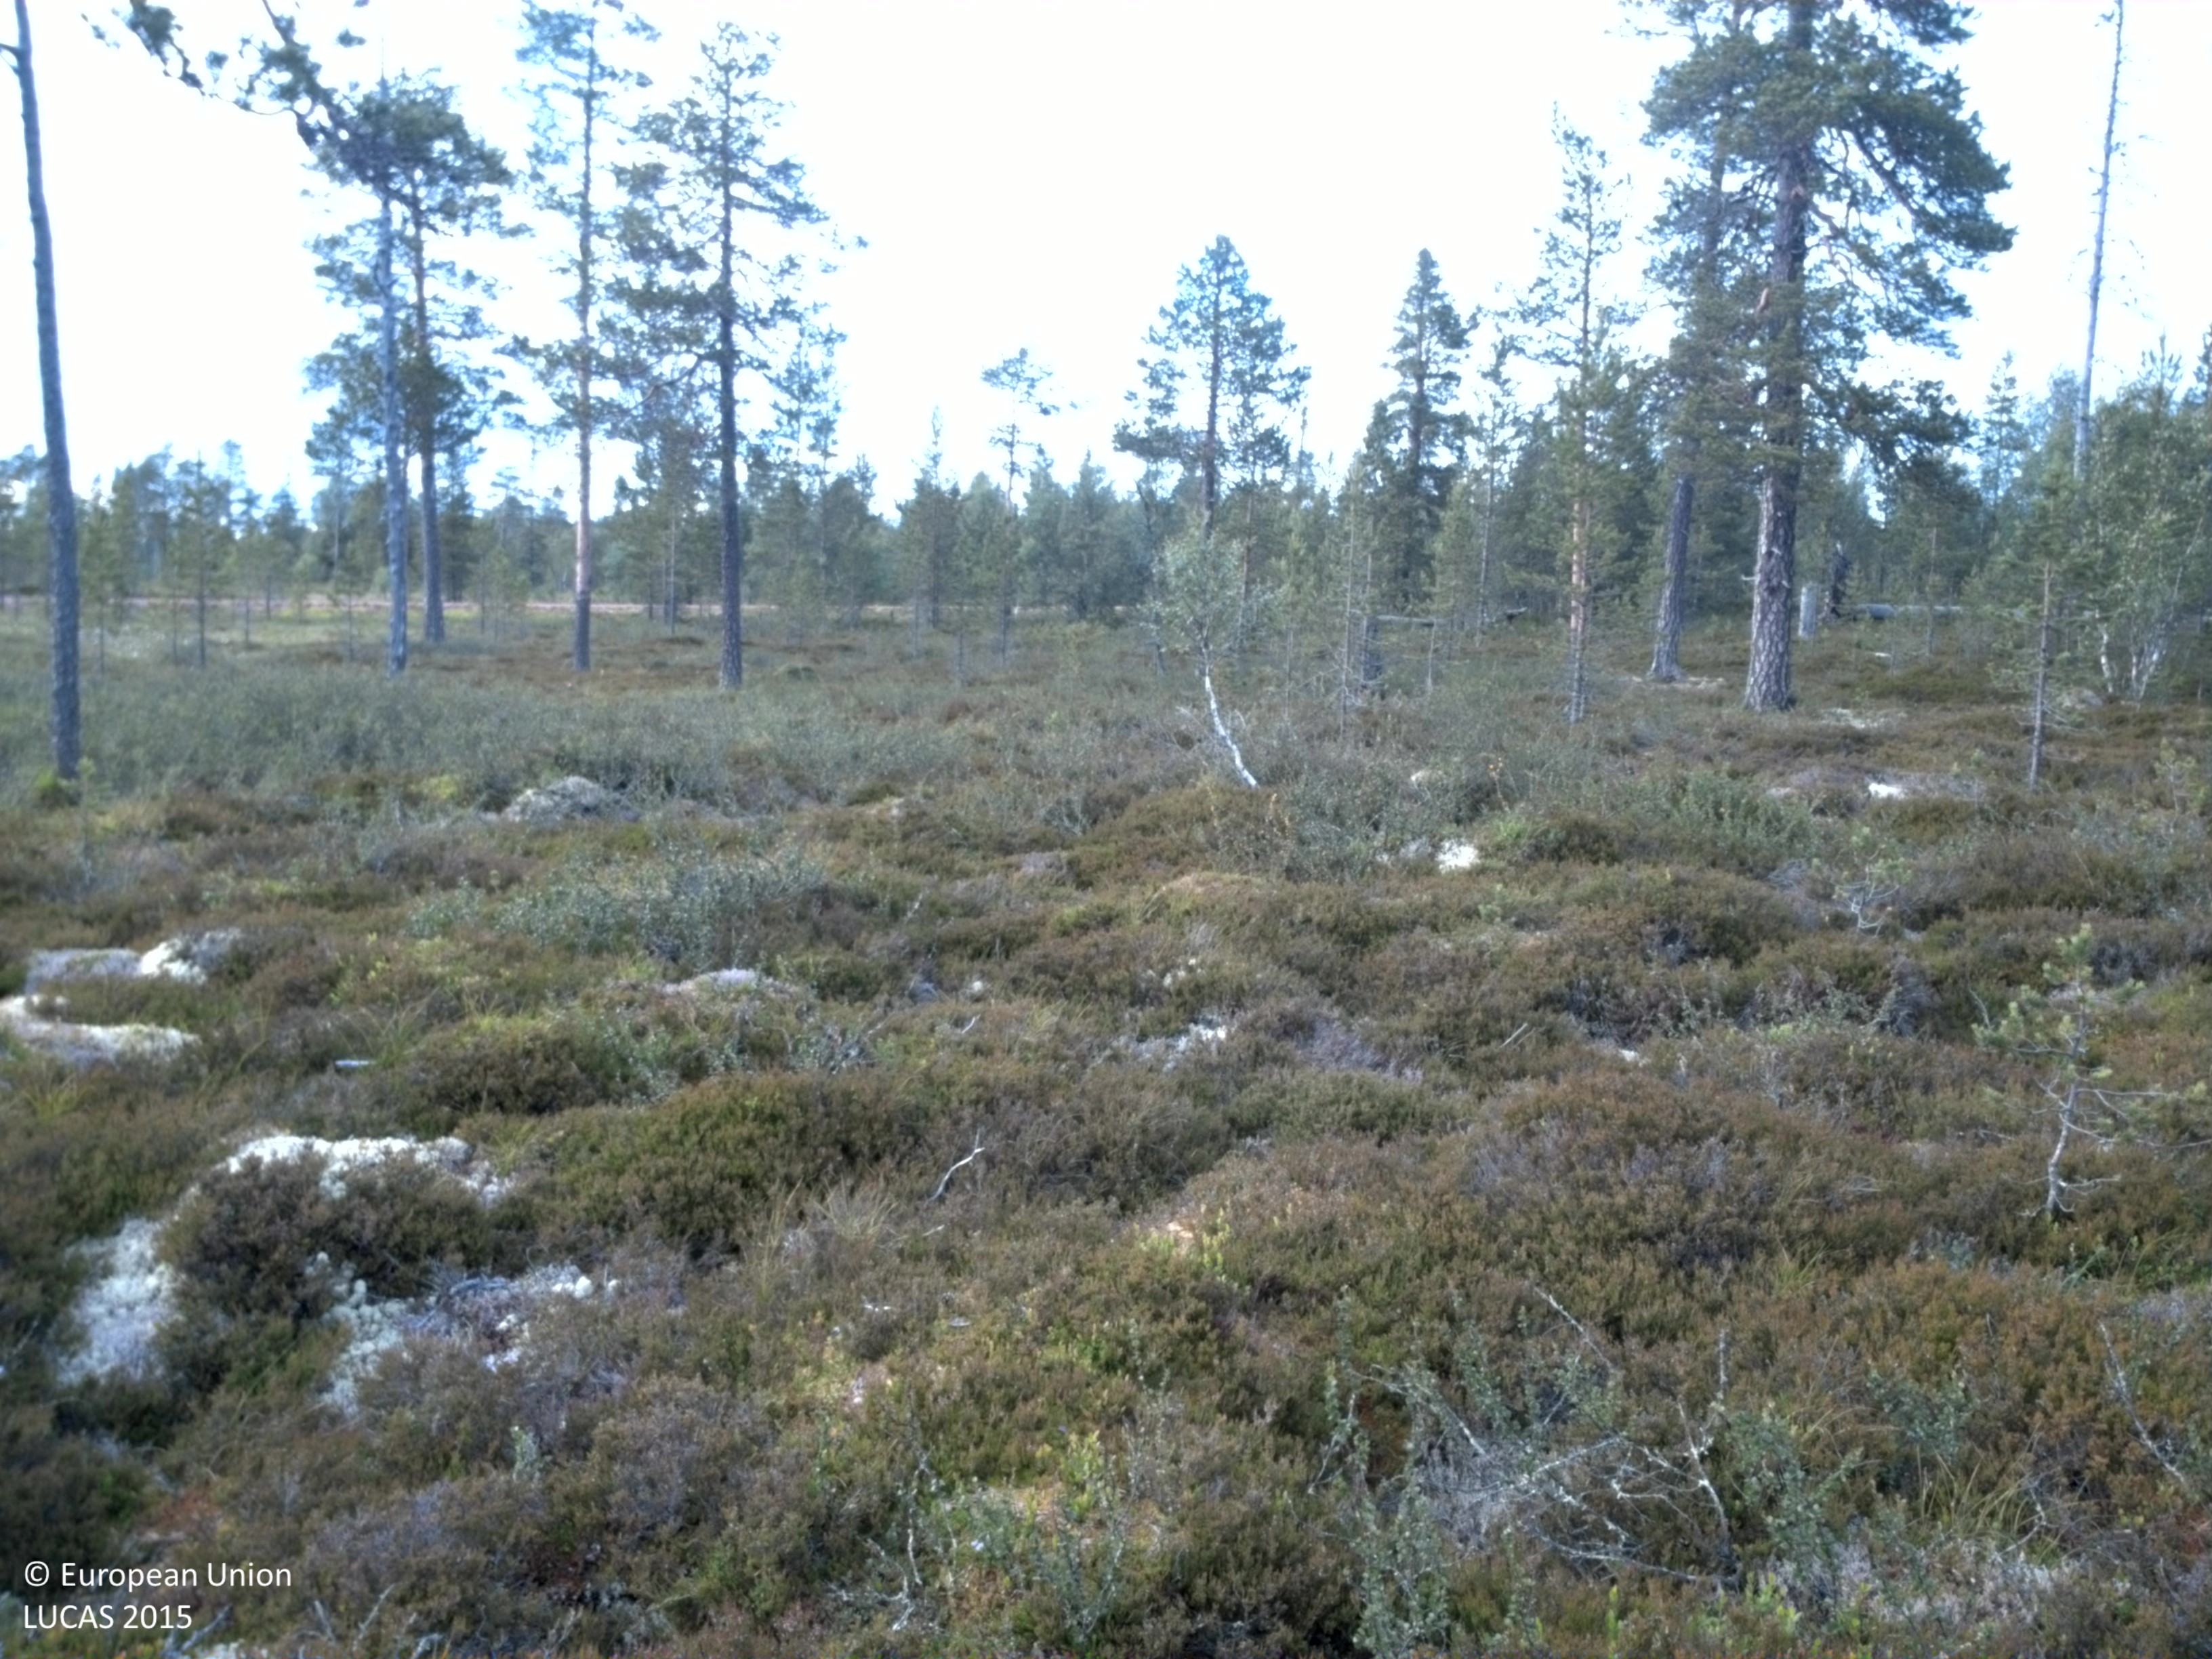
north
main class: Woodland
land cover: Pine dominated coniferous woodland
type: boreal forest
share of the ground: 10 - 25 %
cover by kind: shrubs 40 %, lichens and mosses 35 %, coniferous forest trees 15 %, herbaceous plants 10 %
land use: Forestry
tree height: < 5 m
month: July
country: SE
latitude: 61.5944
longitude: 13.6236
